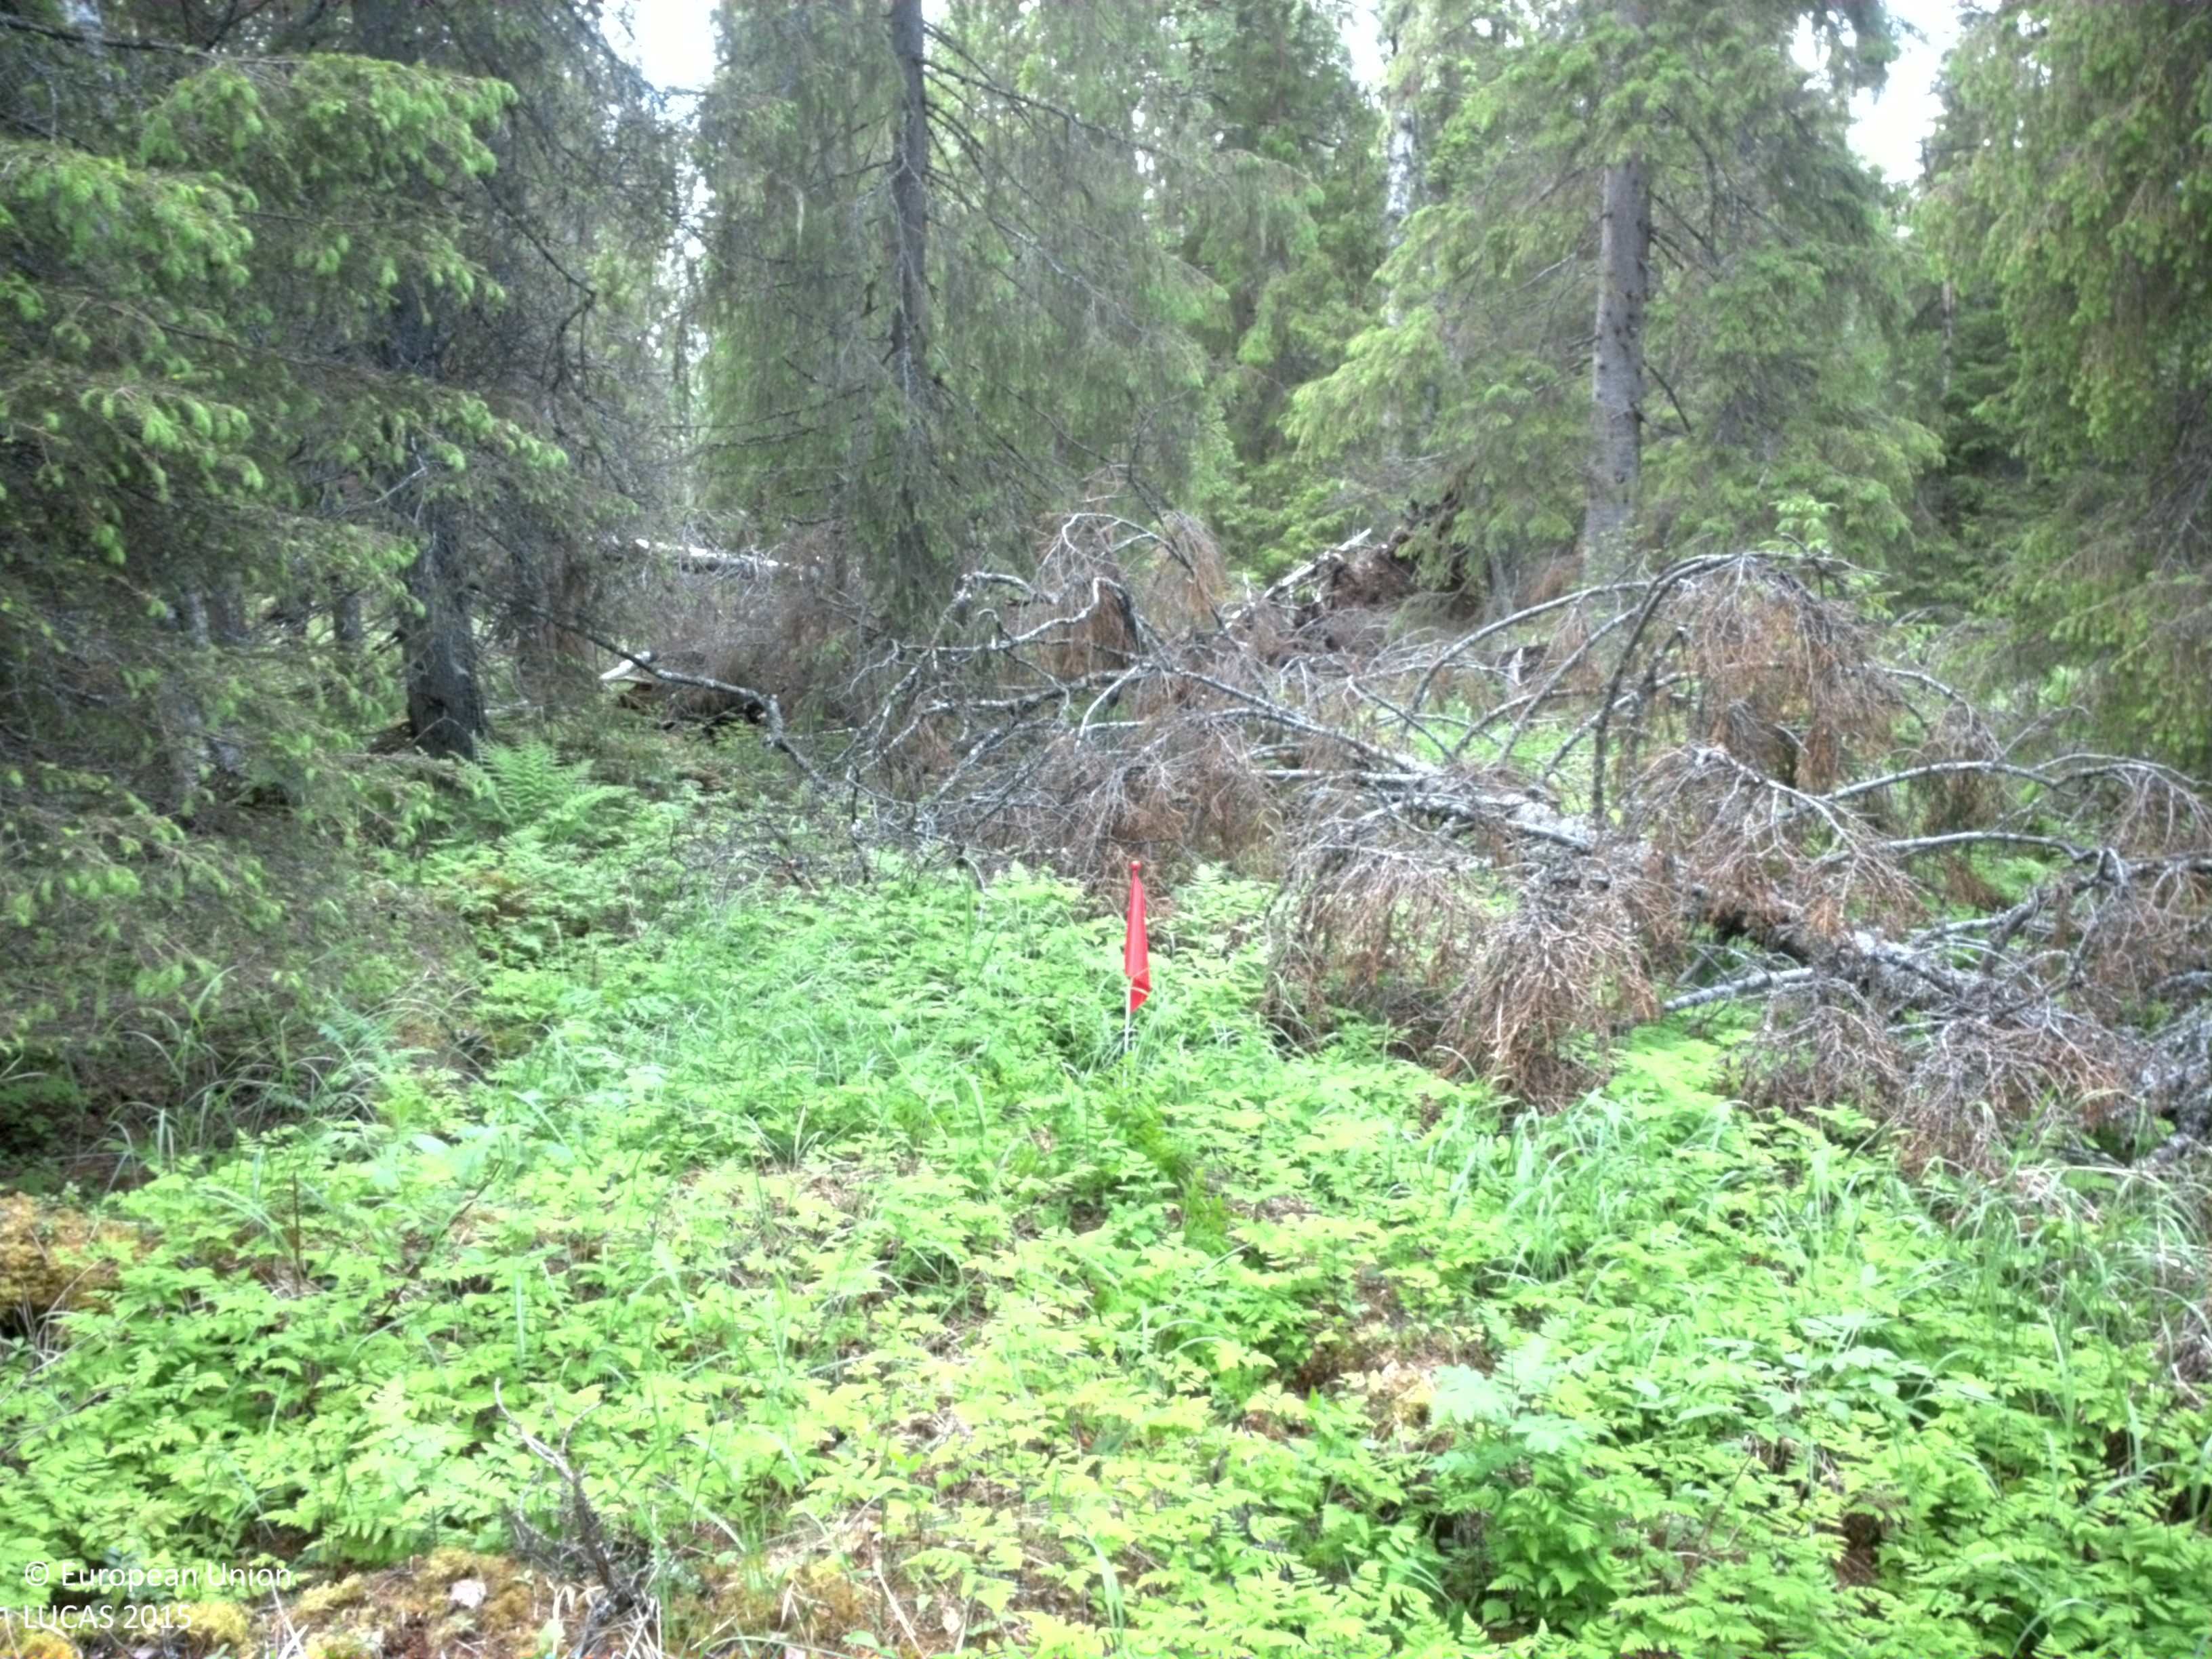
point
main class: Woodland
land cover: Spruce dominated coniferous woodland
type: boreal forest
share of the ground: 50 - 75 %
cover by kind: coniferous forest trees 70 %, herbaceous plants 25 %, broadleaved forest trees 5 %
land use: Forestry
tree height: > 5 m
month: July
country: SE
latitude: 64.5175
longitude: 18.1128
